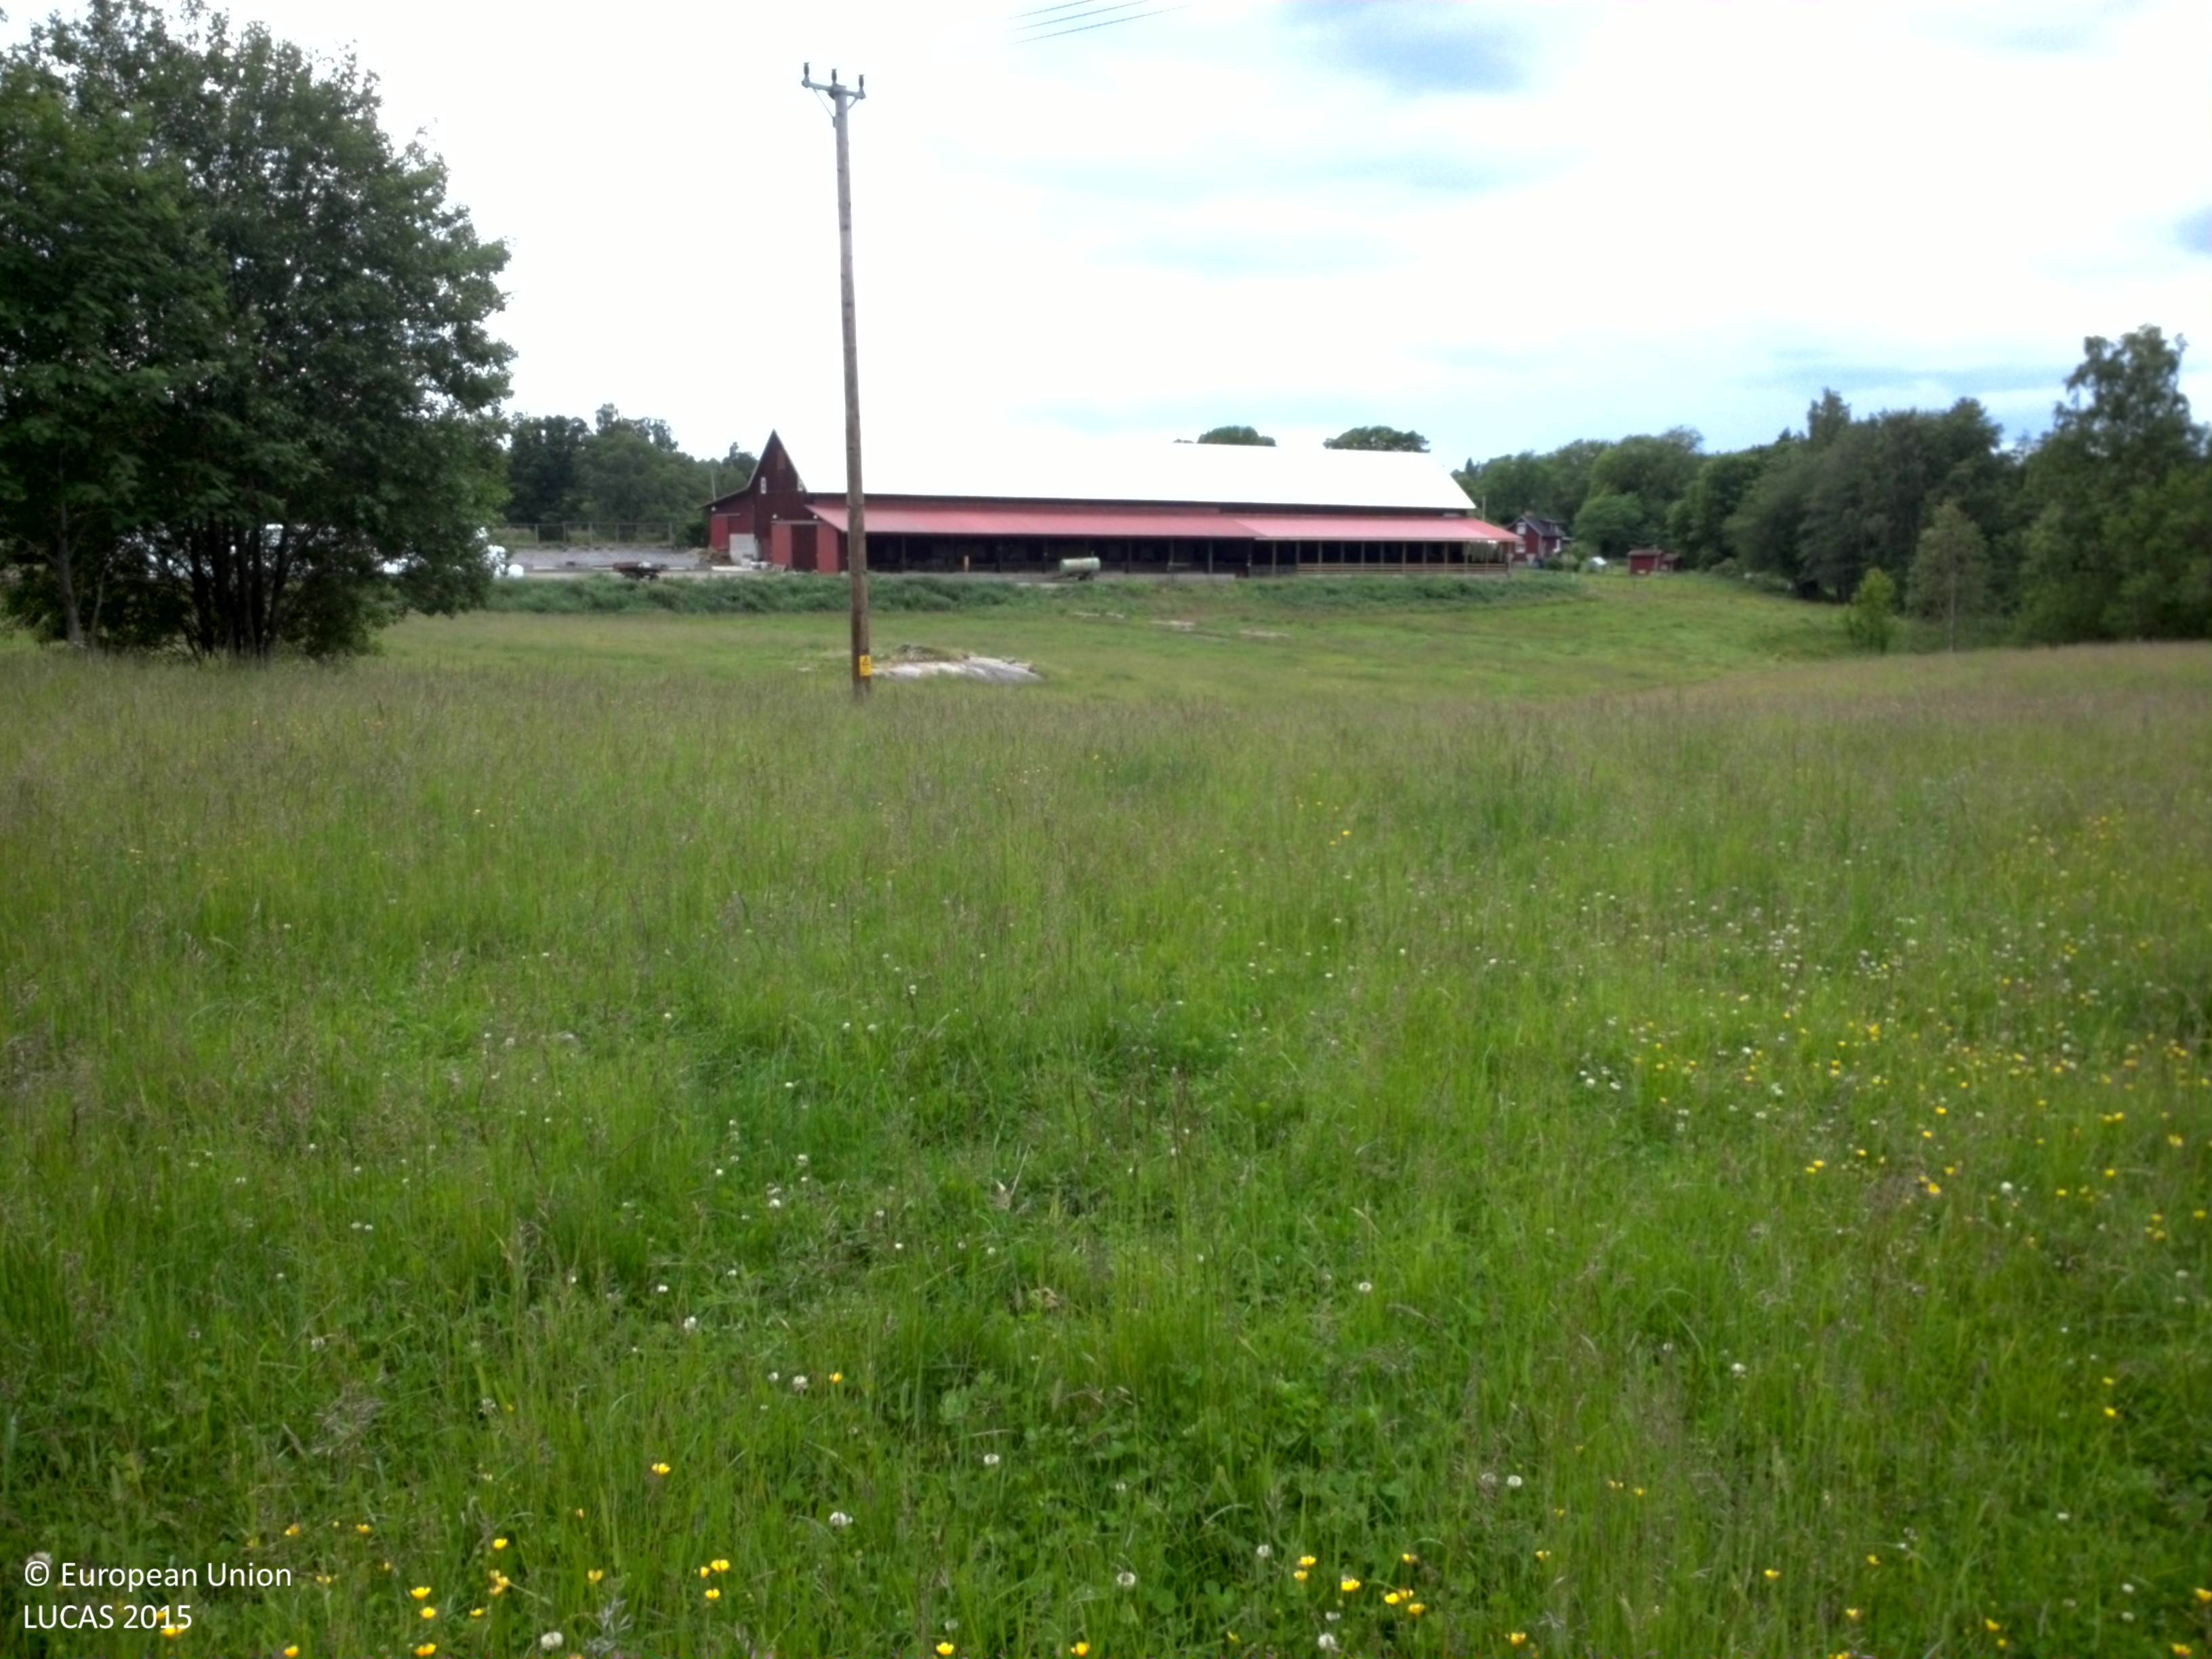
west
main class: Grassland
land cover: Grassland without tree/shrub cover
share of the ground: > 75 %
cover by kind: herbaceous plants 100 %
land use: Agriculture (excluding fallow land and kitchen gardens)
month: June
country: SE
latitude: 58.7173
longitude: 15.5706
